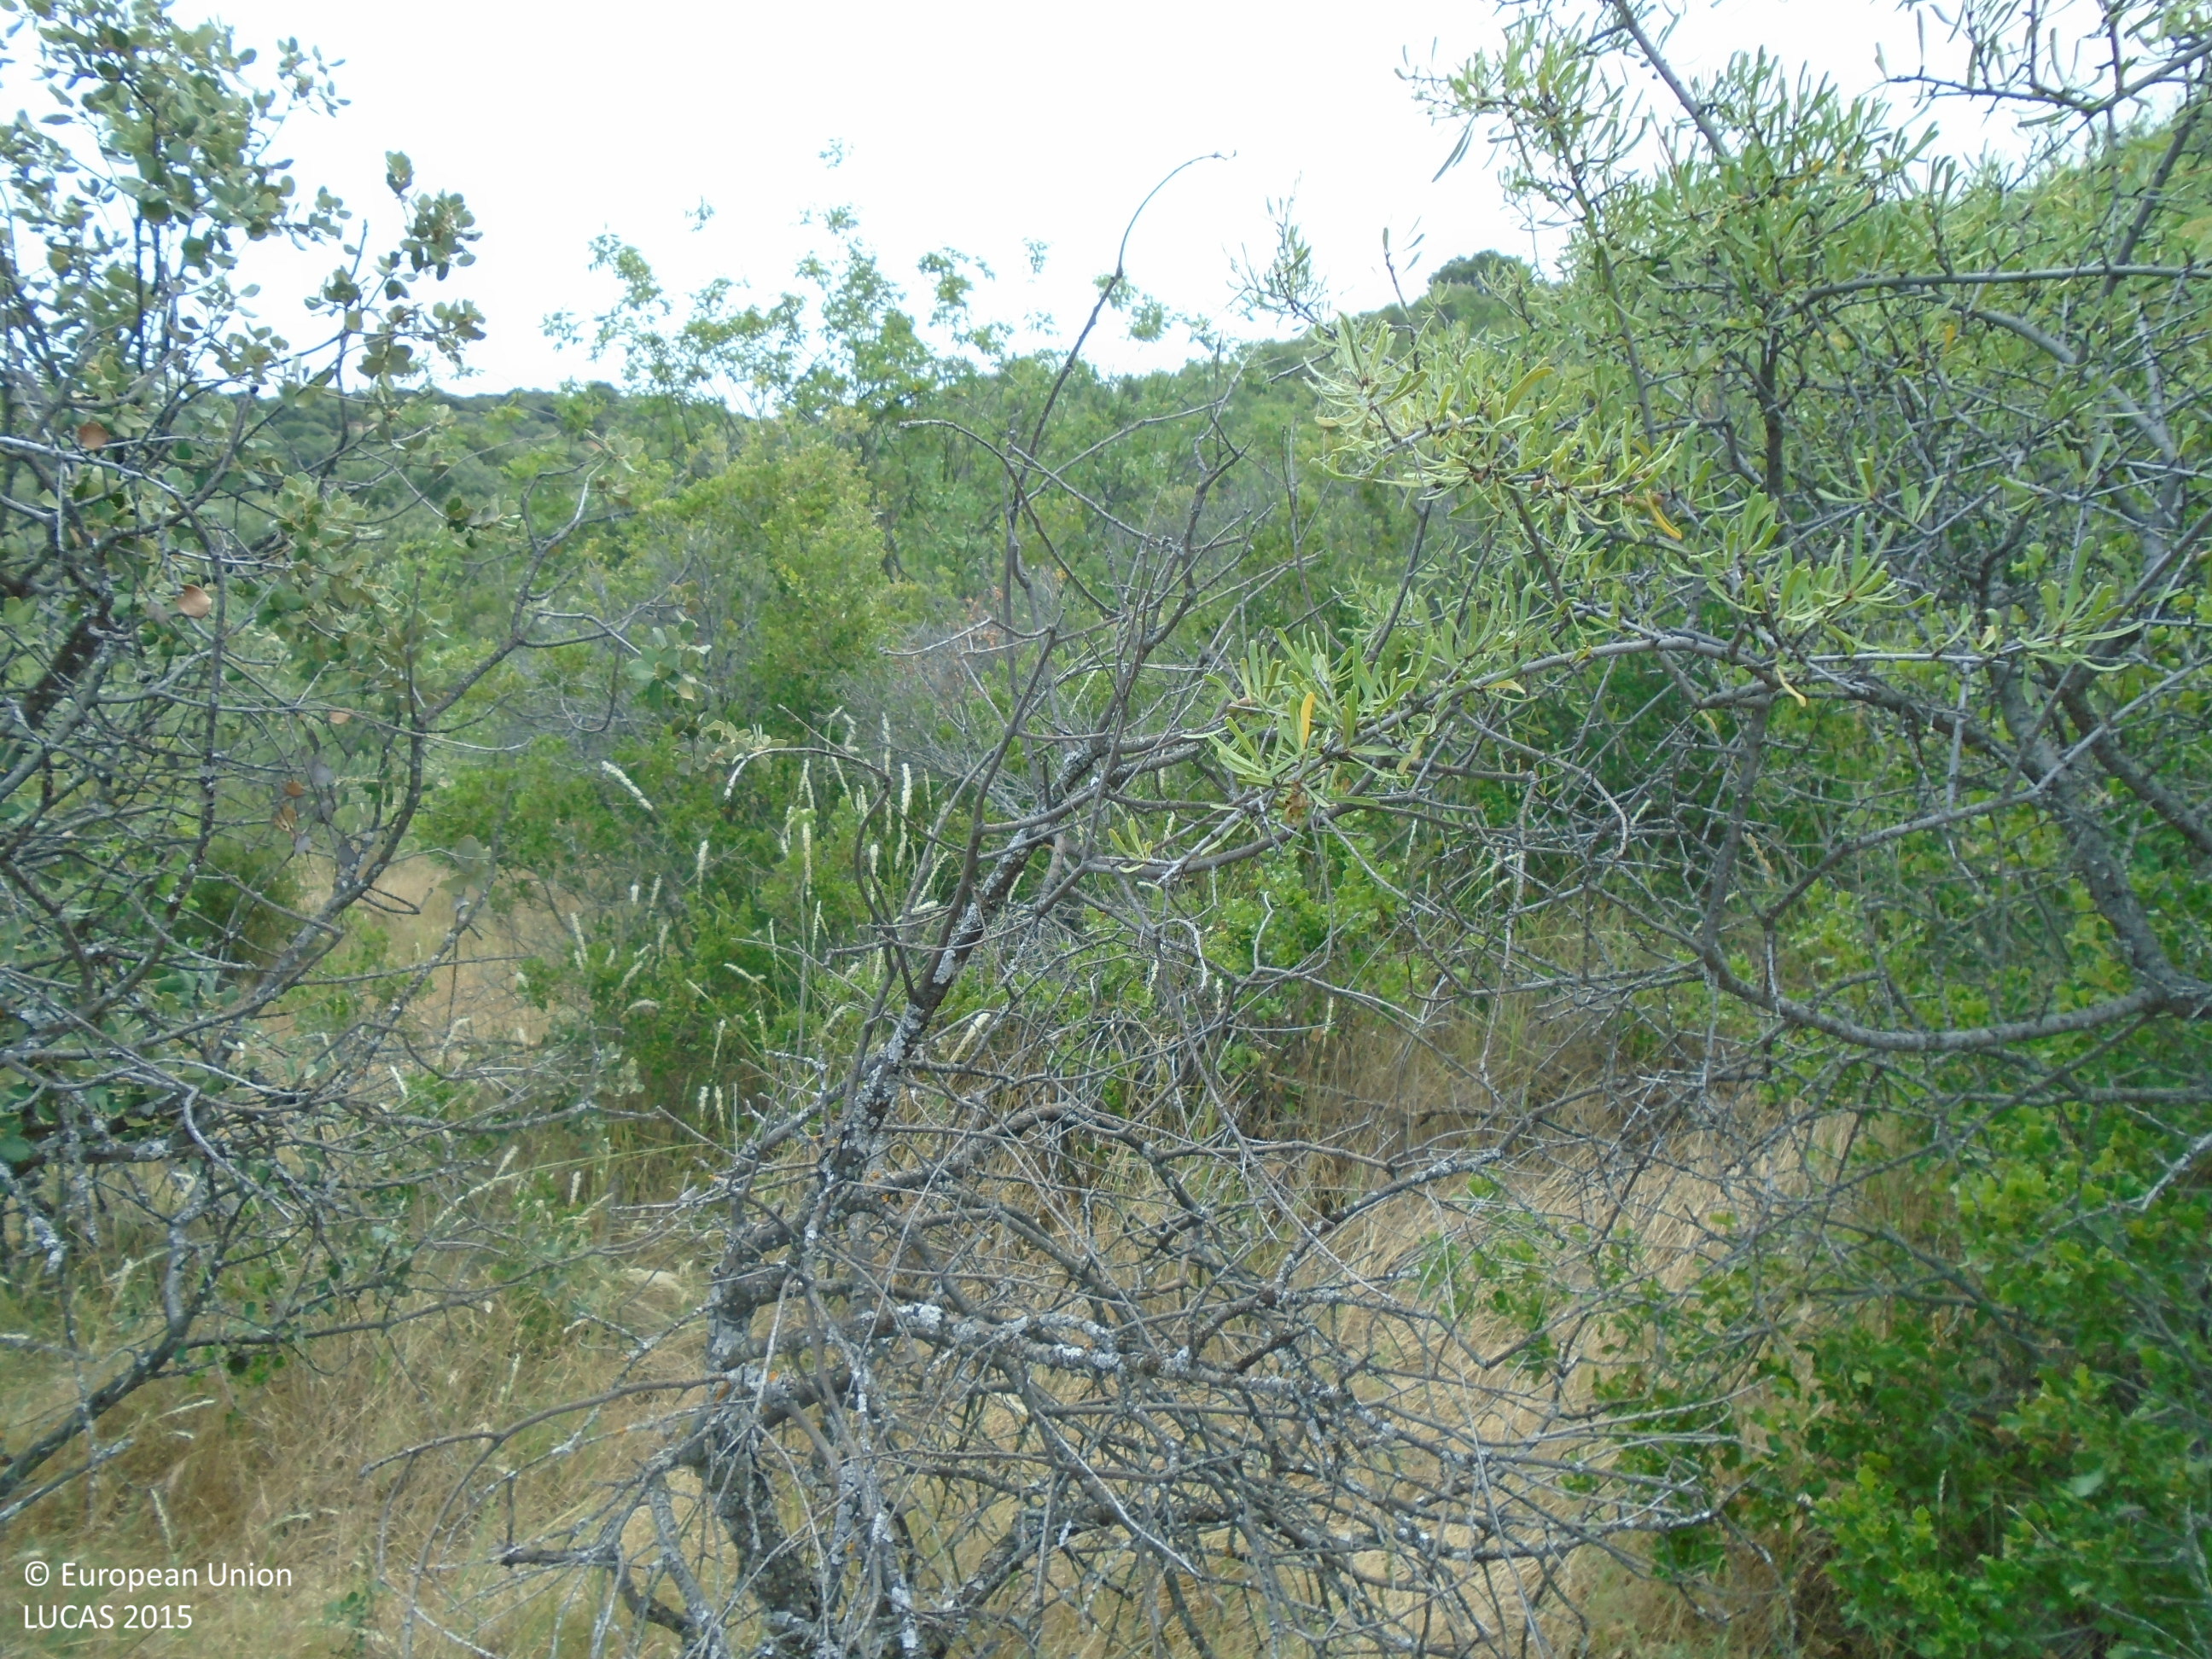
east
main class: Shrubland
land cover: Shrubland without tree cover
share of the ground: > 75 %
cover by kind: shrubs 95 %, herbaceous plants 5 %
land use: Other primary production
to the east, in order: Shrubland without tree cover; Tracks; Olive groves
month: June
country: ES
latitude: 39.8180
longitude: -4.1833
